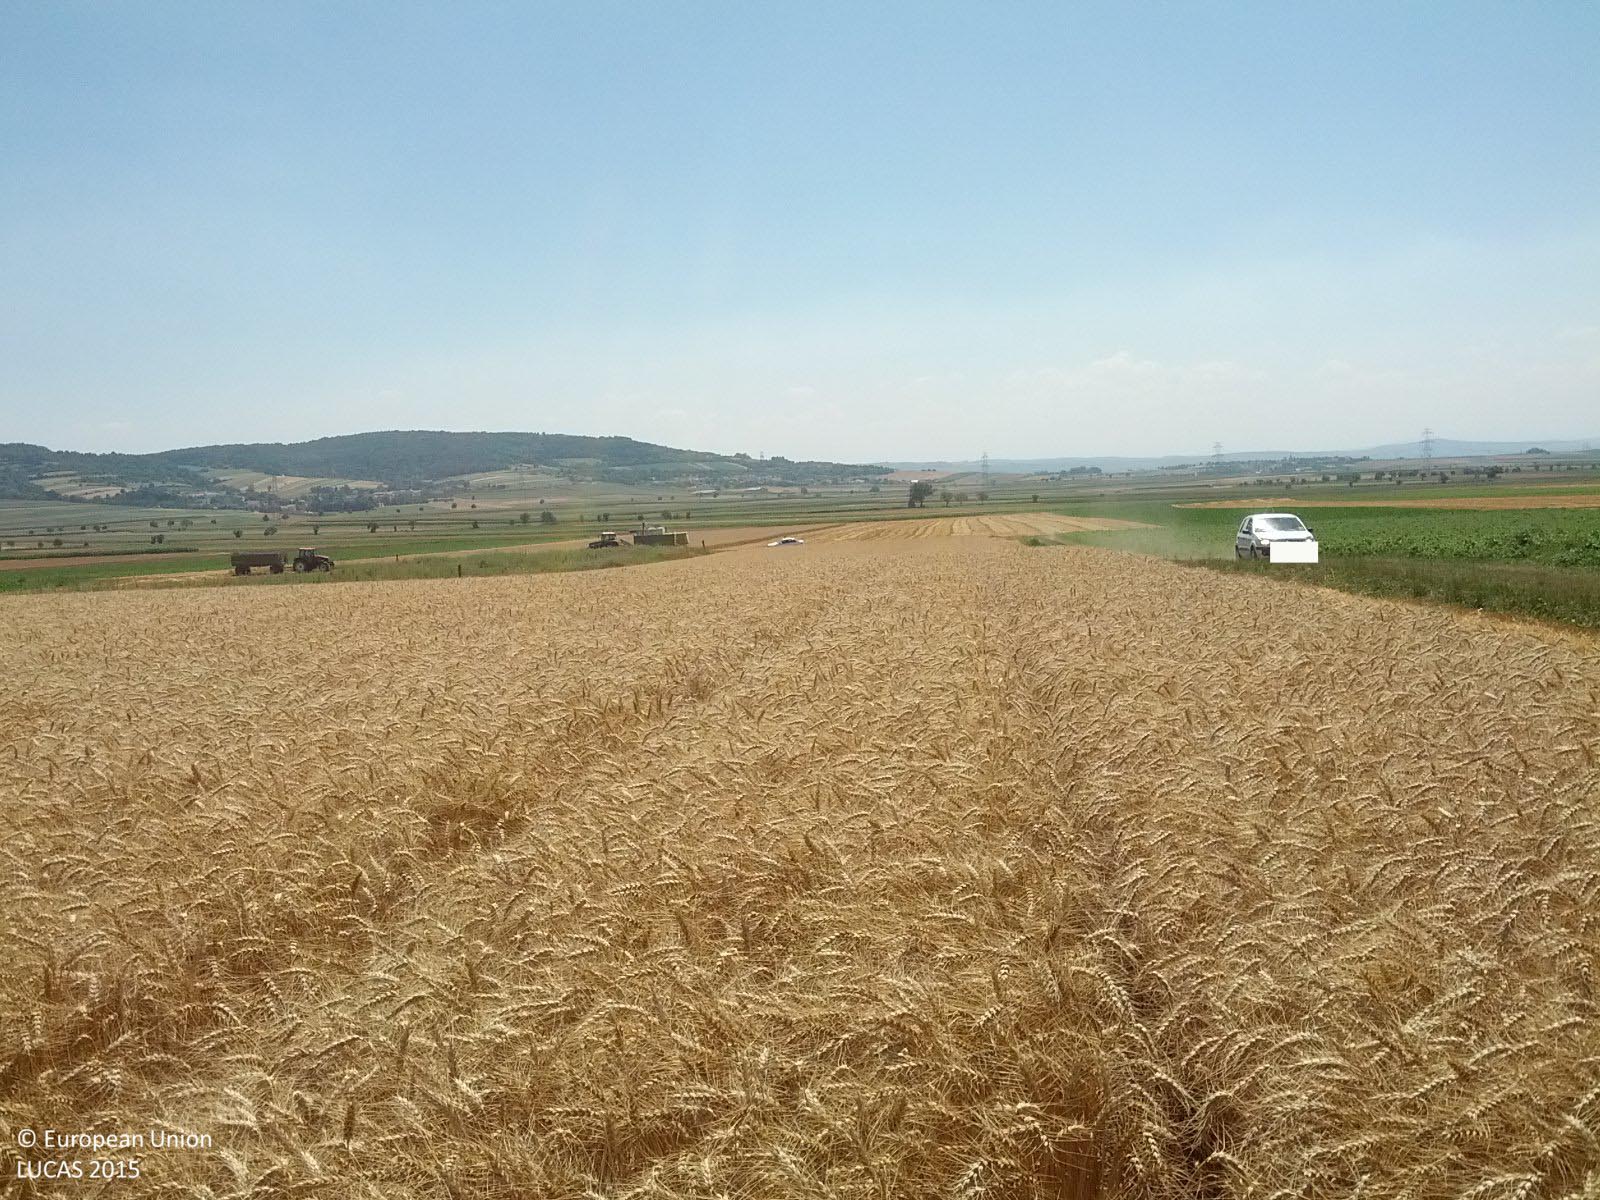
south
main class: Cropland
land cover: Common wheat
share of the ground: > 75 %
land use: Agriculture (excluding fallow land and kitchen gardens)
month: July
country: AT
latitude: 48.4603
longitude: 16.2663
